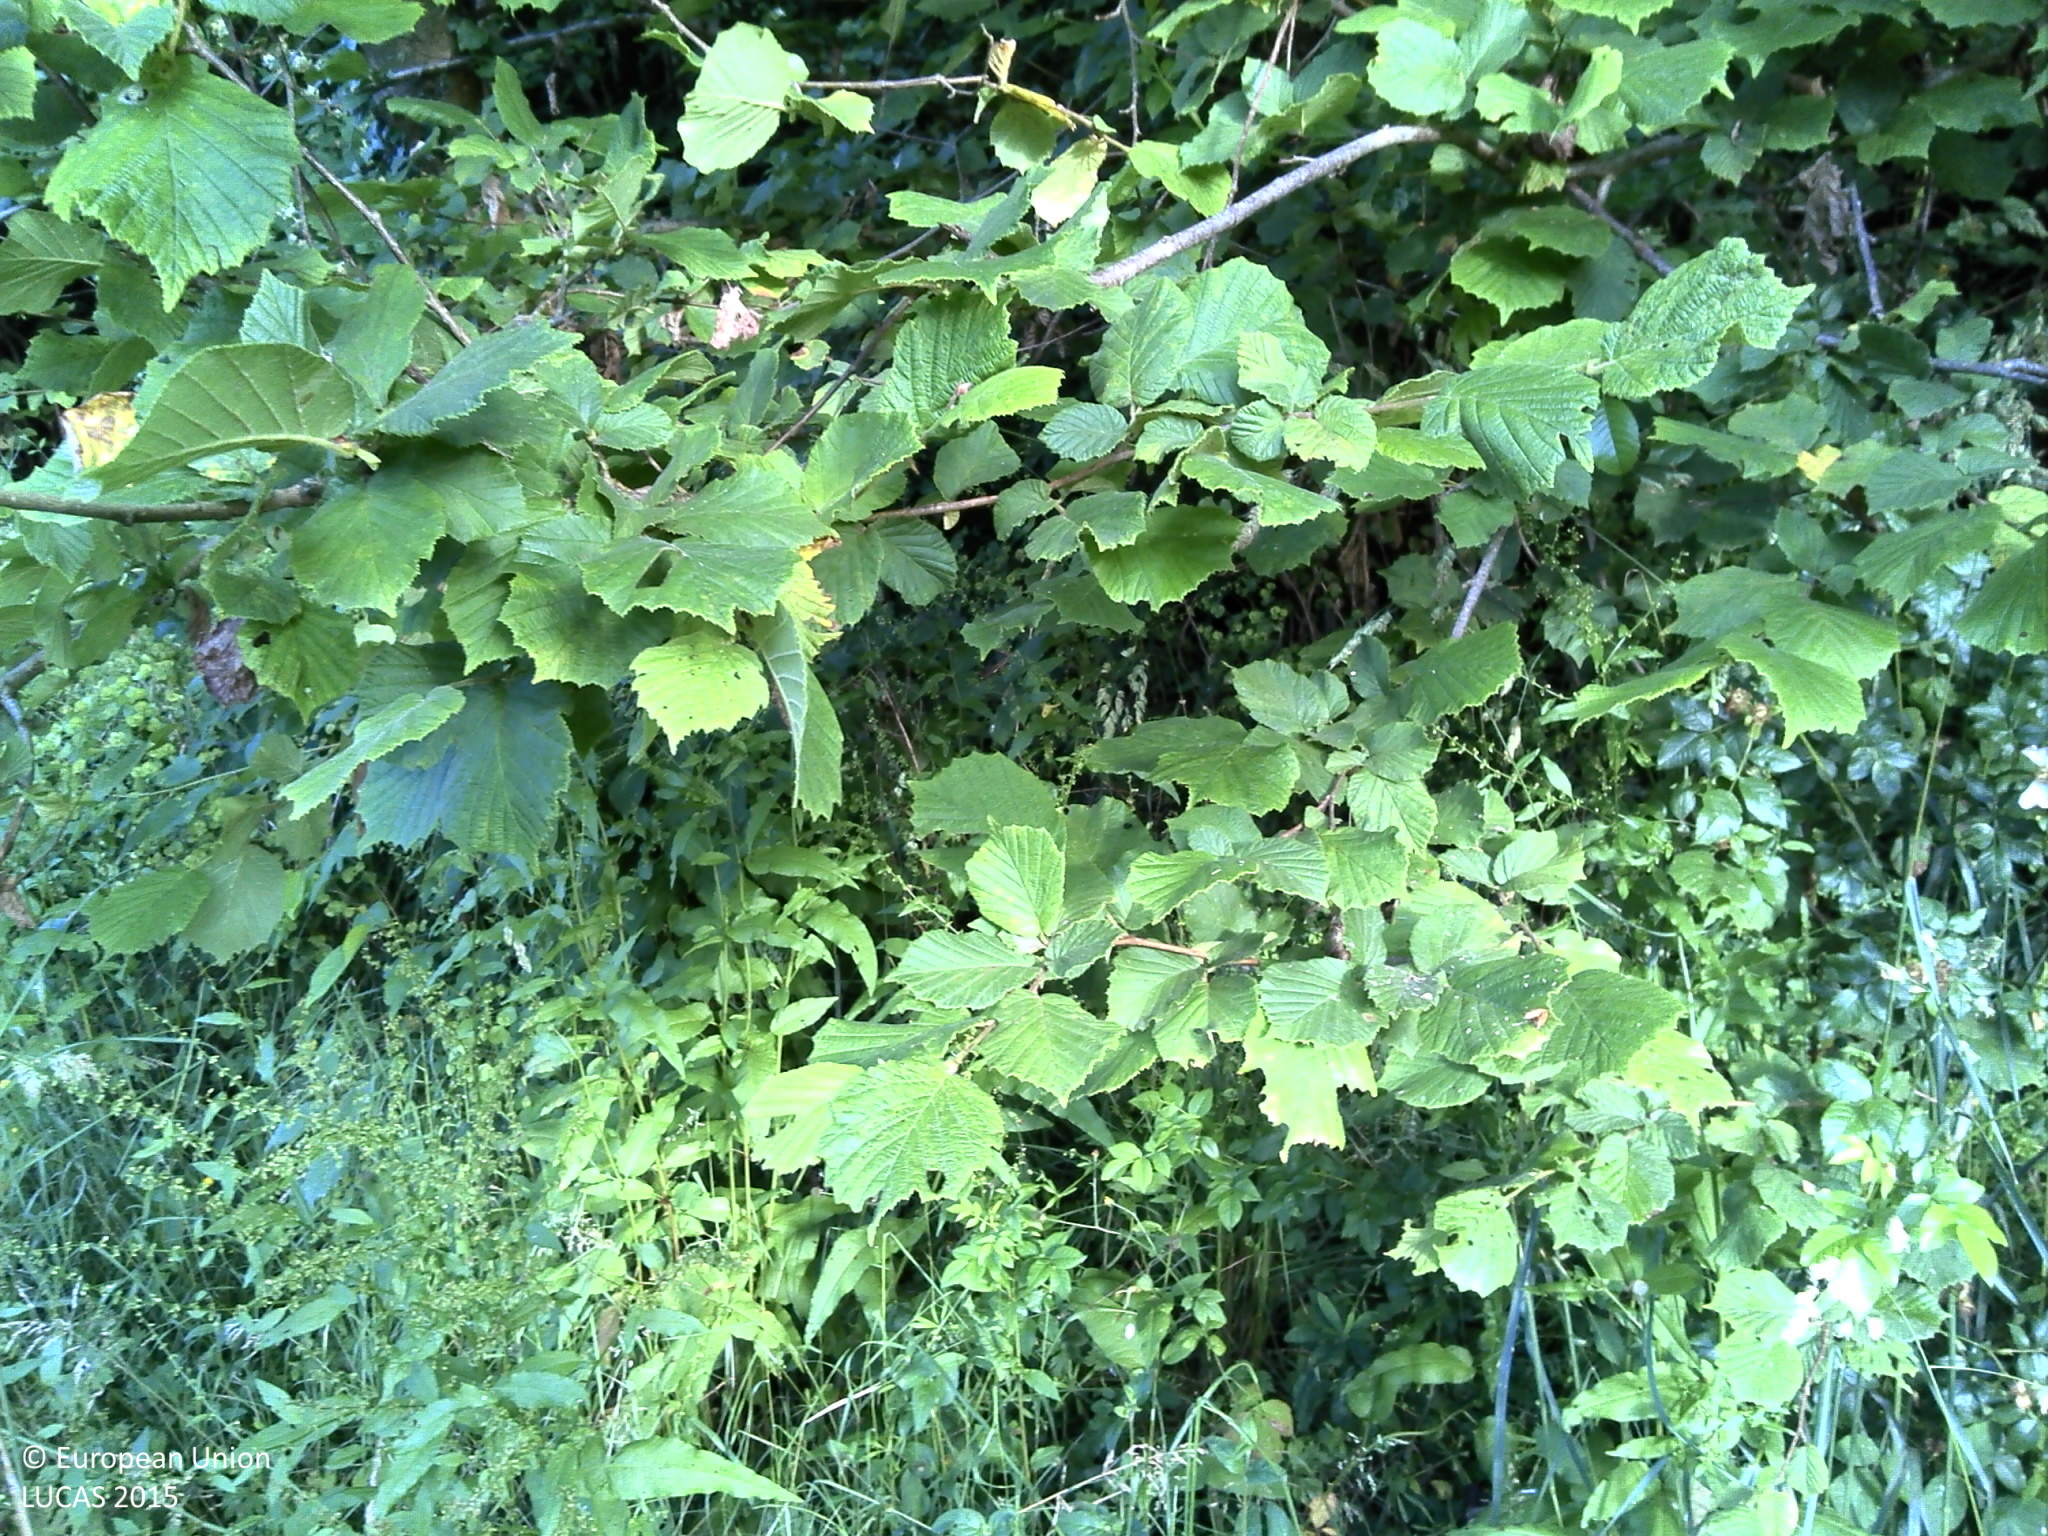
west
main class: Woodland
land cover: Broadleaved woodland
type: acidophilous oak and oak-birch forest
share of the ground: 50 - 75 %
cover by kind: broadleaved forest trees 70 %, herbaceous plants 30 %
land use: Forestry
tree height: > 5 m
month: June
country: FR
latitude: 49.7150
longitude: 0.9483
